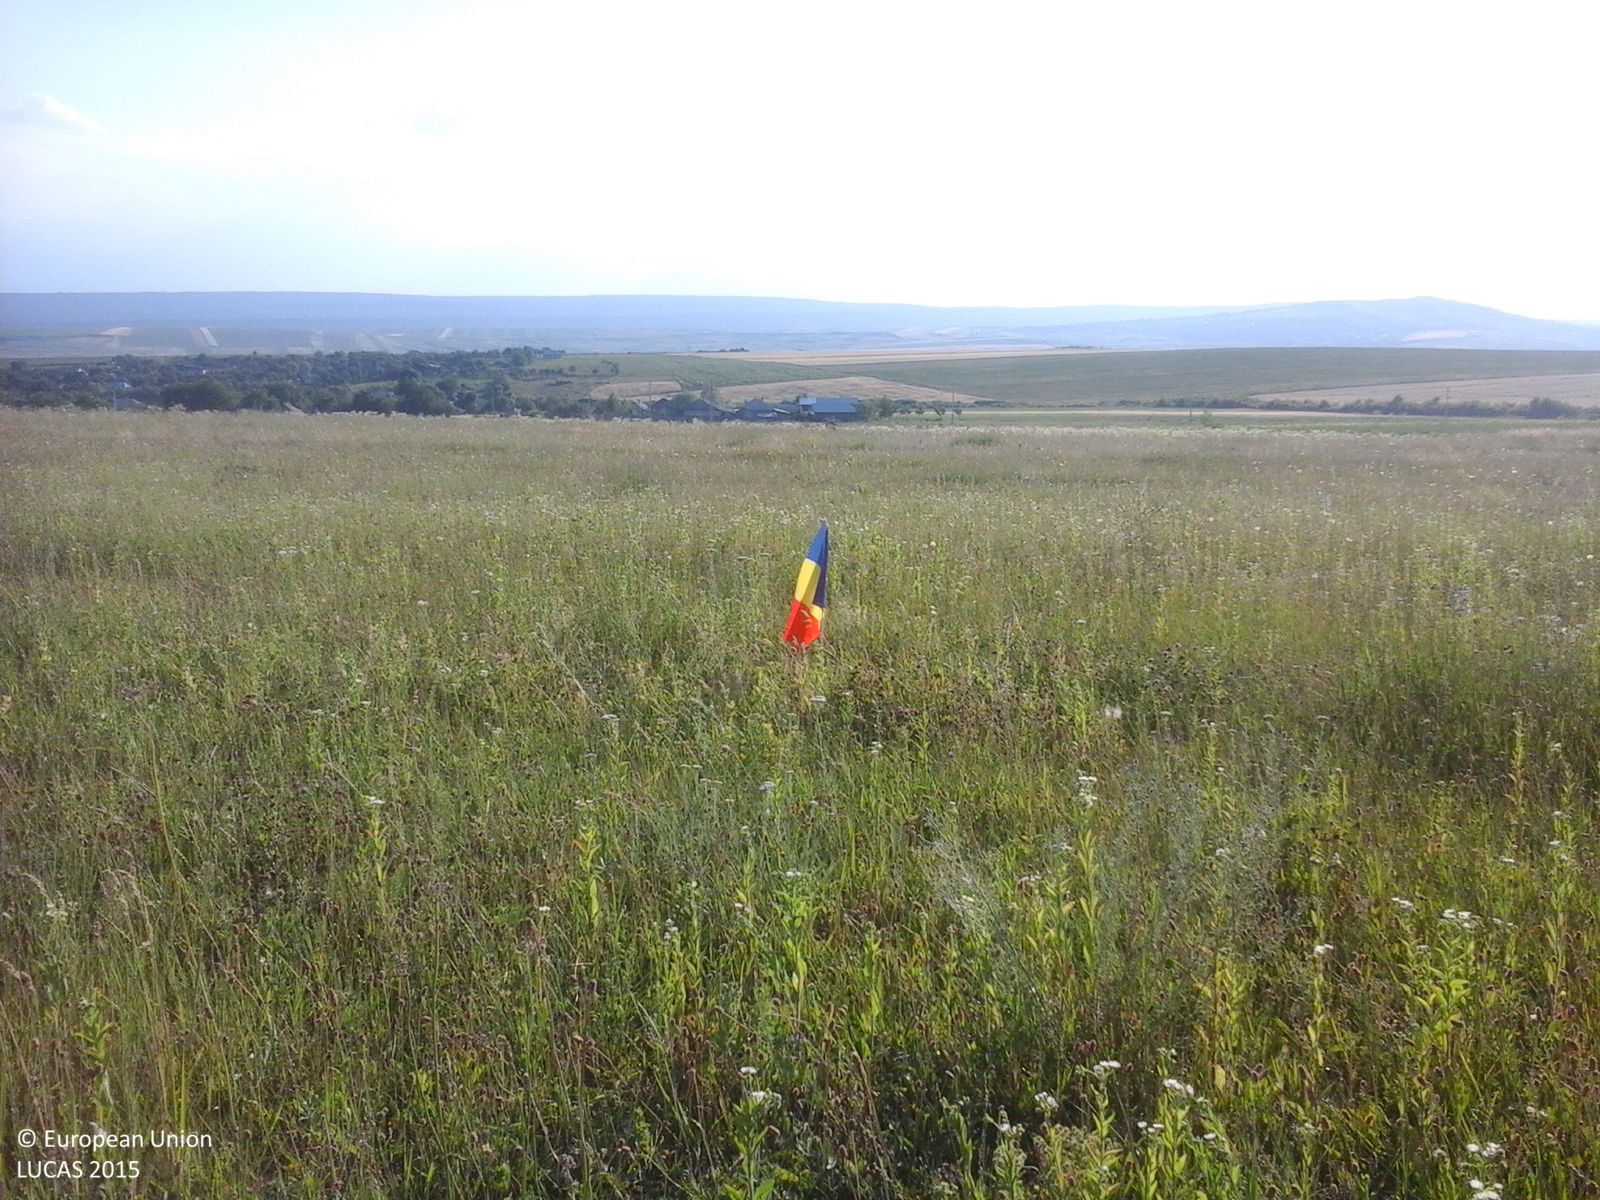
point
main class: Grassland
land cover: Grassland without tree/shrub cover
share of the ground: > 75 %
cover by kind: herbaceous plants 100 %
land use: Agriculture (excluding fallow land and kitchen gardens)
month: June
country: RO
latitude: 46.9774
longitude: 27.3706
